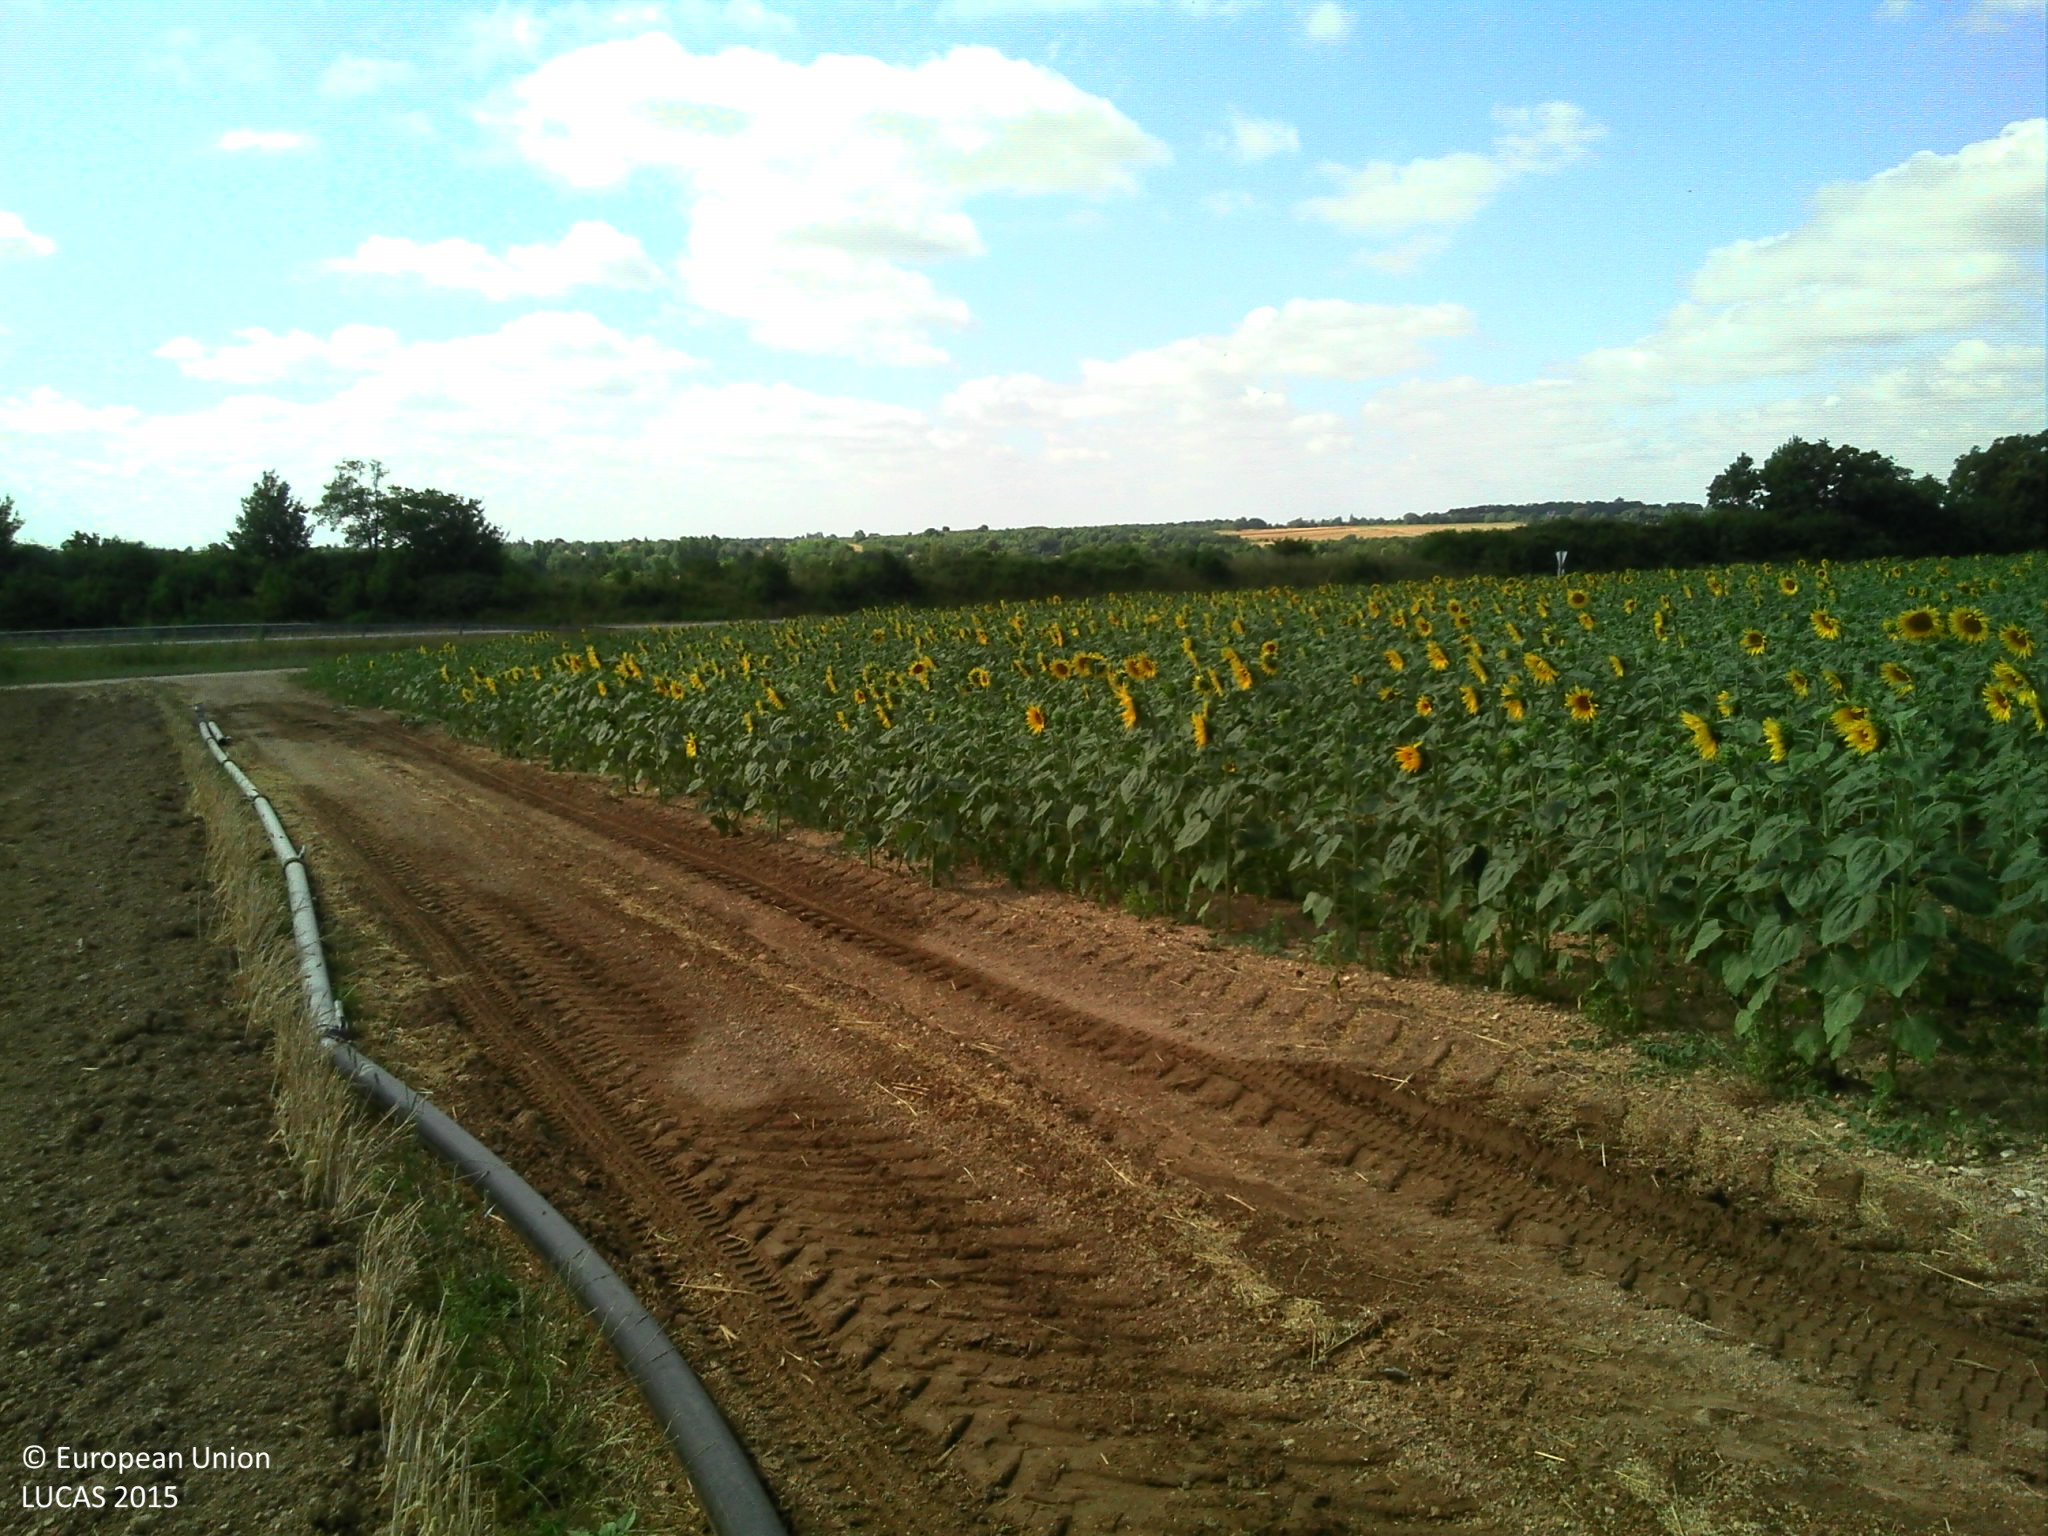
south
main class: Cropland
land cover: Sunflower
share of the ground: > 75 %
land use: Agriculture (excluding fallow land and kitchen gardens)
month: July
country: FR
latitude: 46.6325
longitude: 0.2751
